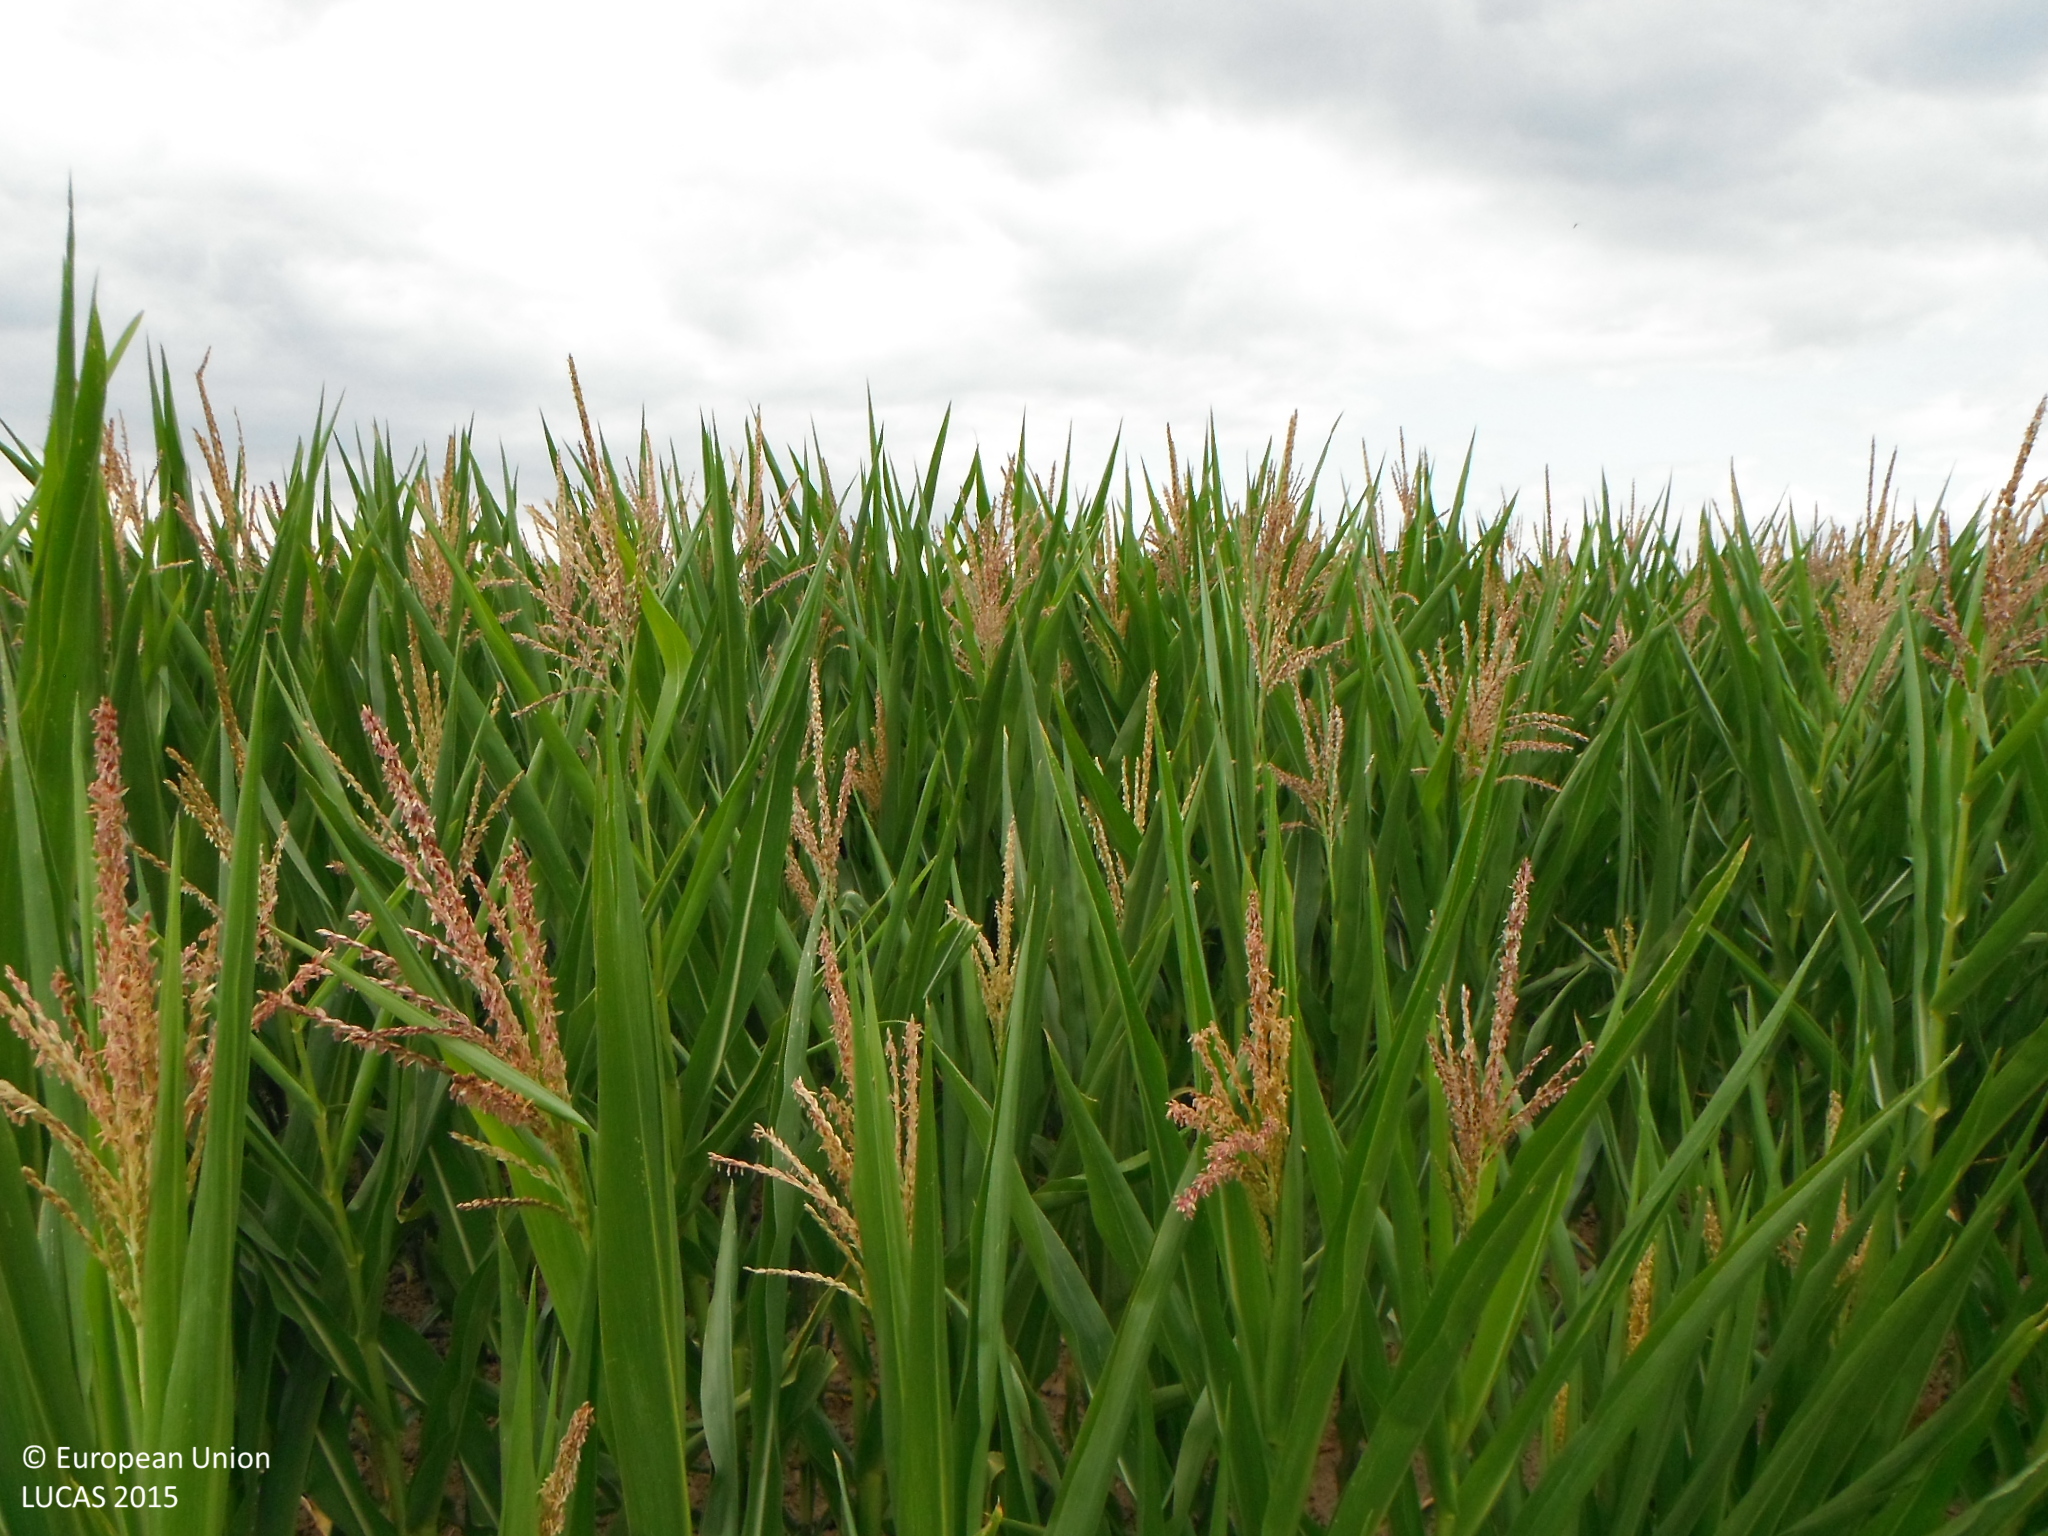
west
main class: Cropland
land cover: Maize
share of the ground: > 75 %
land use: Agriculture (excluding fallow land and kitchen gardens)
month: July
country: SK
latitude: 48.2728
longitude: 18.9798
